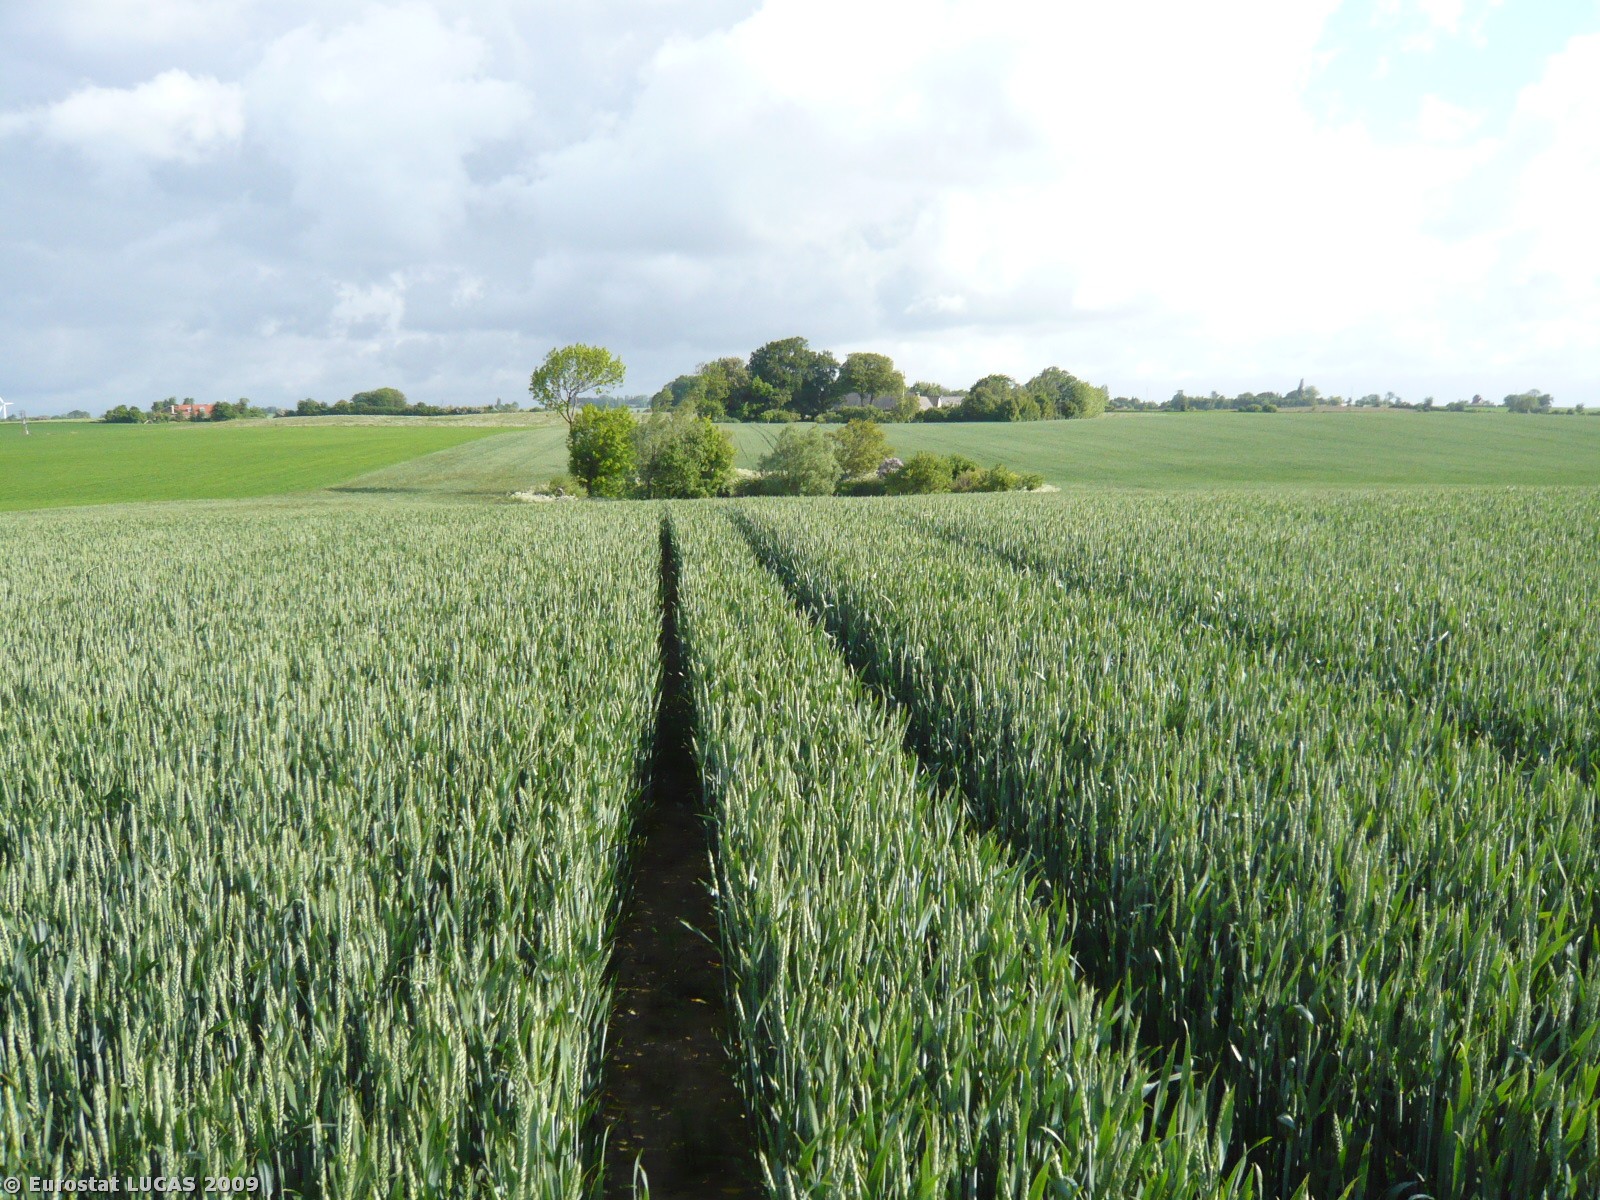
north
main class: Cropland
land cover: Common wheat
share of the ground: > 75 %
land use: Agriculture (excluding fallow land and kitchen gardens)
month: June
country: DK
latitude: 54.9451
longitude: 12.2623
